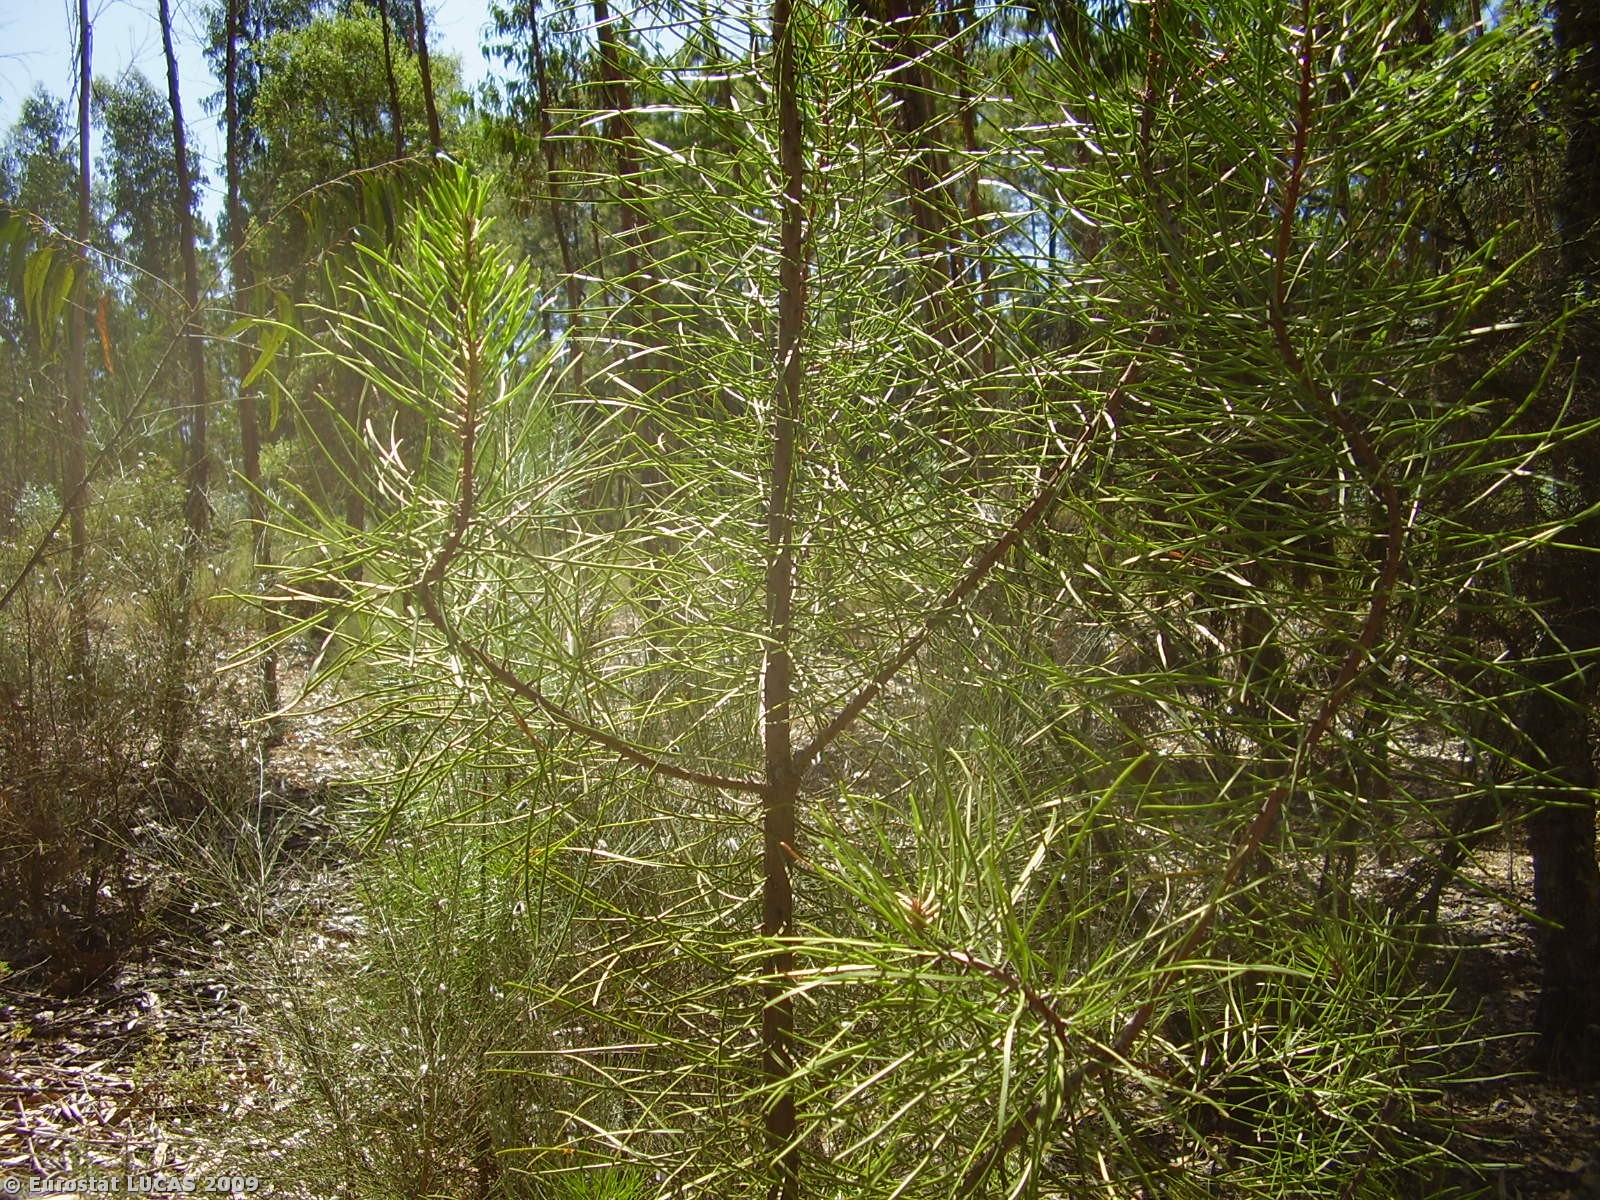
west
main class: Woodland
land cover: Mixed woodland
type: plantations and self-sown exotic forest
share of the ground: 25 - 50 %
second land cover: Spontaneously vegetated surfaces
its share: 50 - 75 %
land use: Forestry
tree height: > 5 m
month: July
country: PT
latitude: 39.3521
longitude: -7.9611
